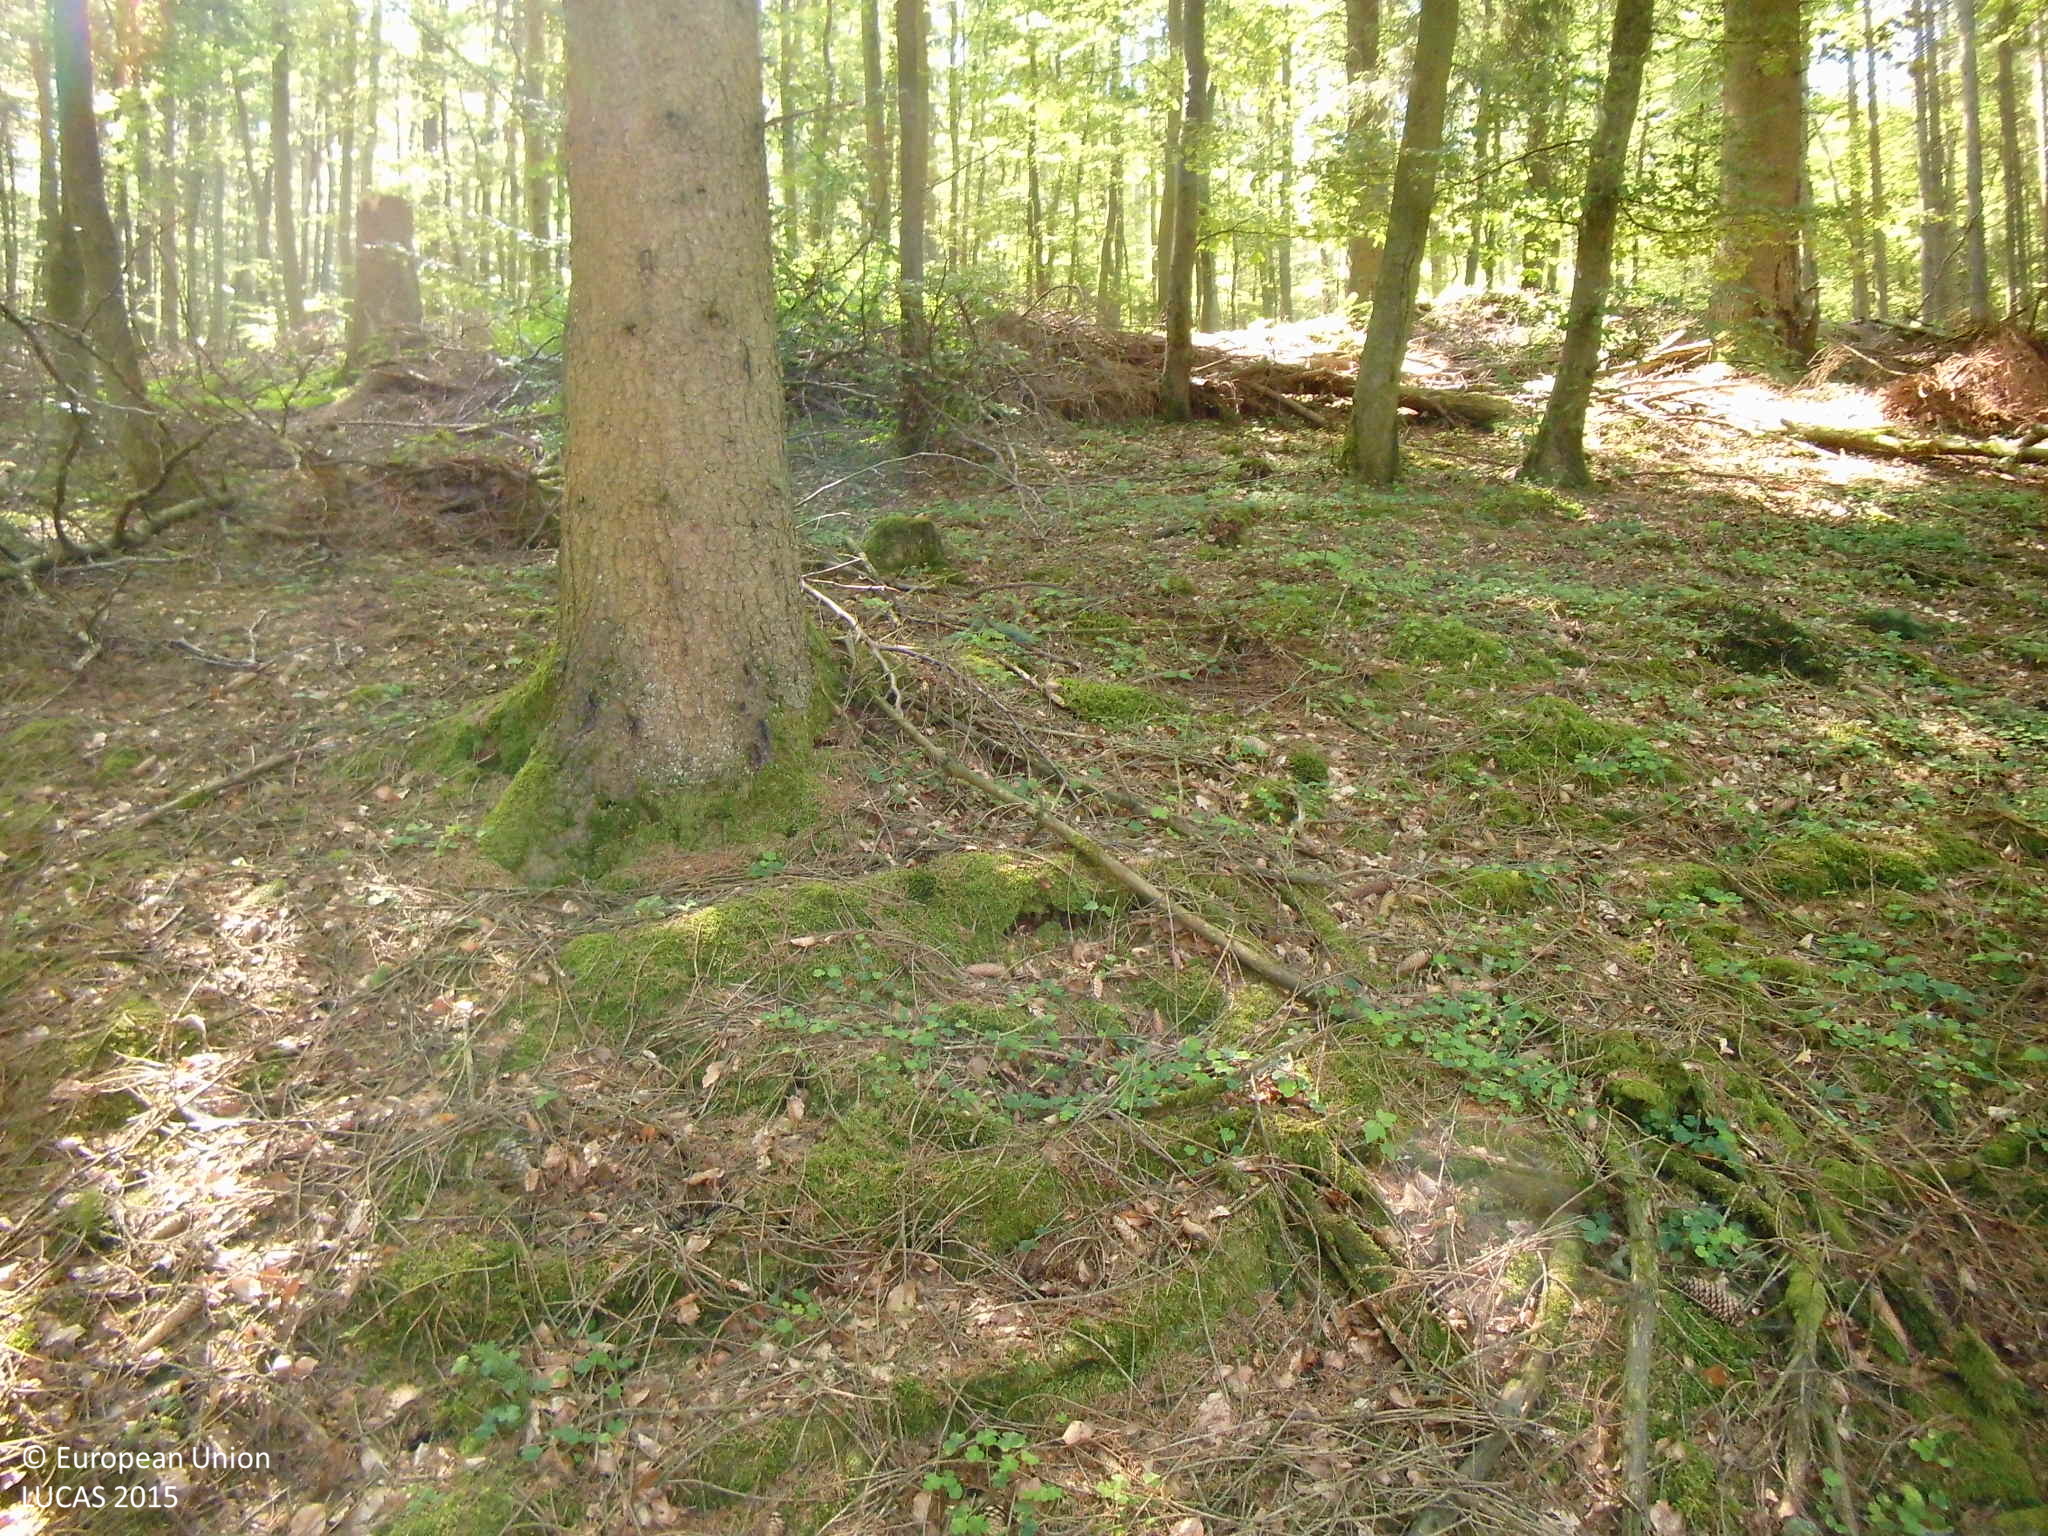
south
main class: Woodland
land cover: Spruce dominated mixed woodland
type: hemiboreal forest and nemoral coniferous forest and mixed broadleaved-coniferous forest
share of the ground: > 75 %
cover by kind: coniferous forest trees 60 %, broadleaved forest trees 25 %, herbaceous plants 5 %, lichens and mosses 5 %, unconsolidated bare surface 5 %
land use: Forestry
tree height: > 5 m
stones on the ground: < 10 %
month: August
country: DE
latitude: 51.1022
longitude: 8.0153
